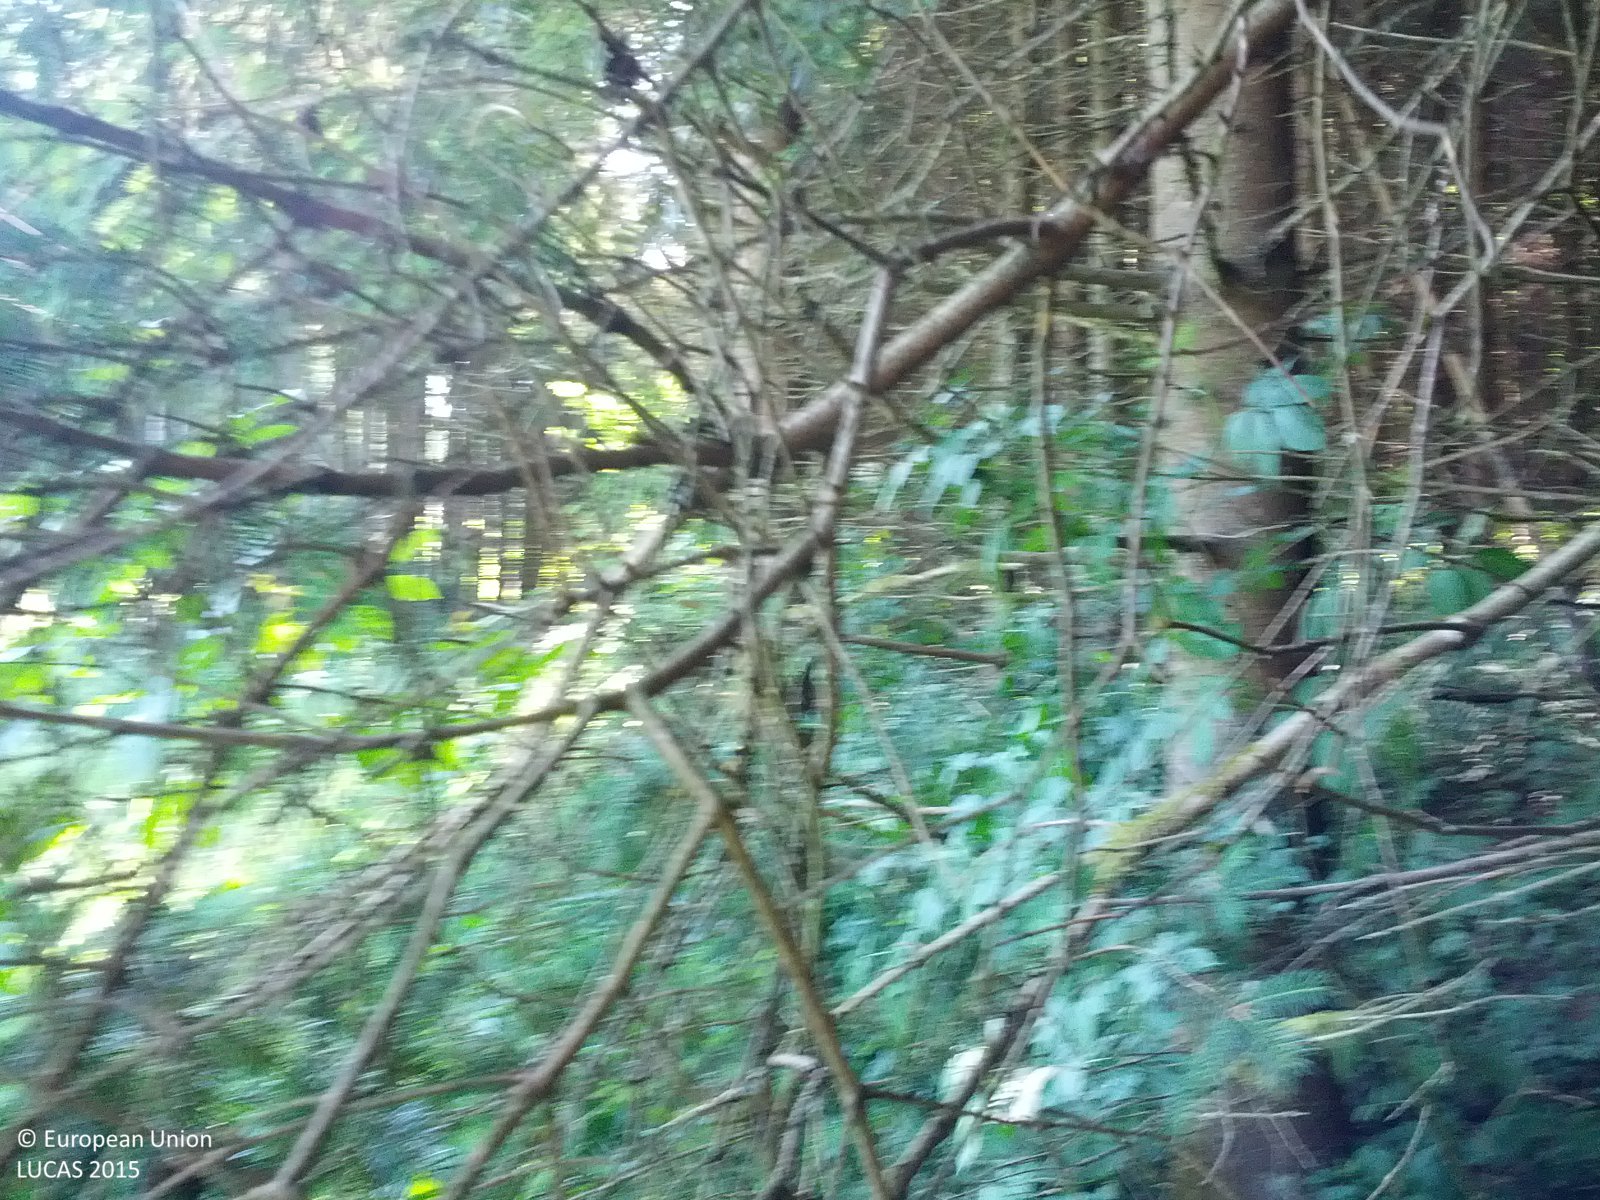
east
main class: Woodland
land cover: Spruce dominated coniferous woodland
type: hemiboreal forest and nemoral coniferous forest and mixed broadleaved-coniferous forest
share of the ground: > 75 %
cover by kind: coniferous forest trees 85 %, herbaceous plants 10 %, broadleaved forest trees 5 %
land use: Forestry
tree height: > 5 m
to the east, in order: Spruce dominated coniferous woodland; Grass margins; Tracks; Grass margins; Spruce dominated coniferous woodland; Grassland without tree/shrub cover; Electric lines; Grassland without tree/shrub cover; Spruce dominated coniferous woodland
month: June
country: AT
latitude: 47.2025
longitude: 16.1669
